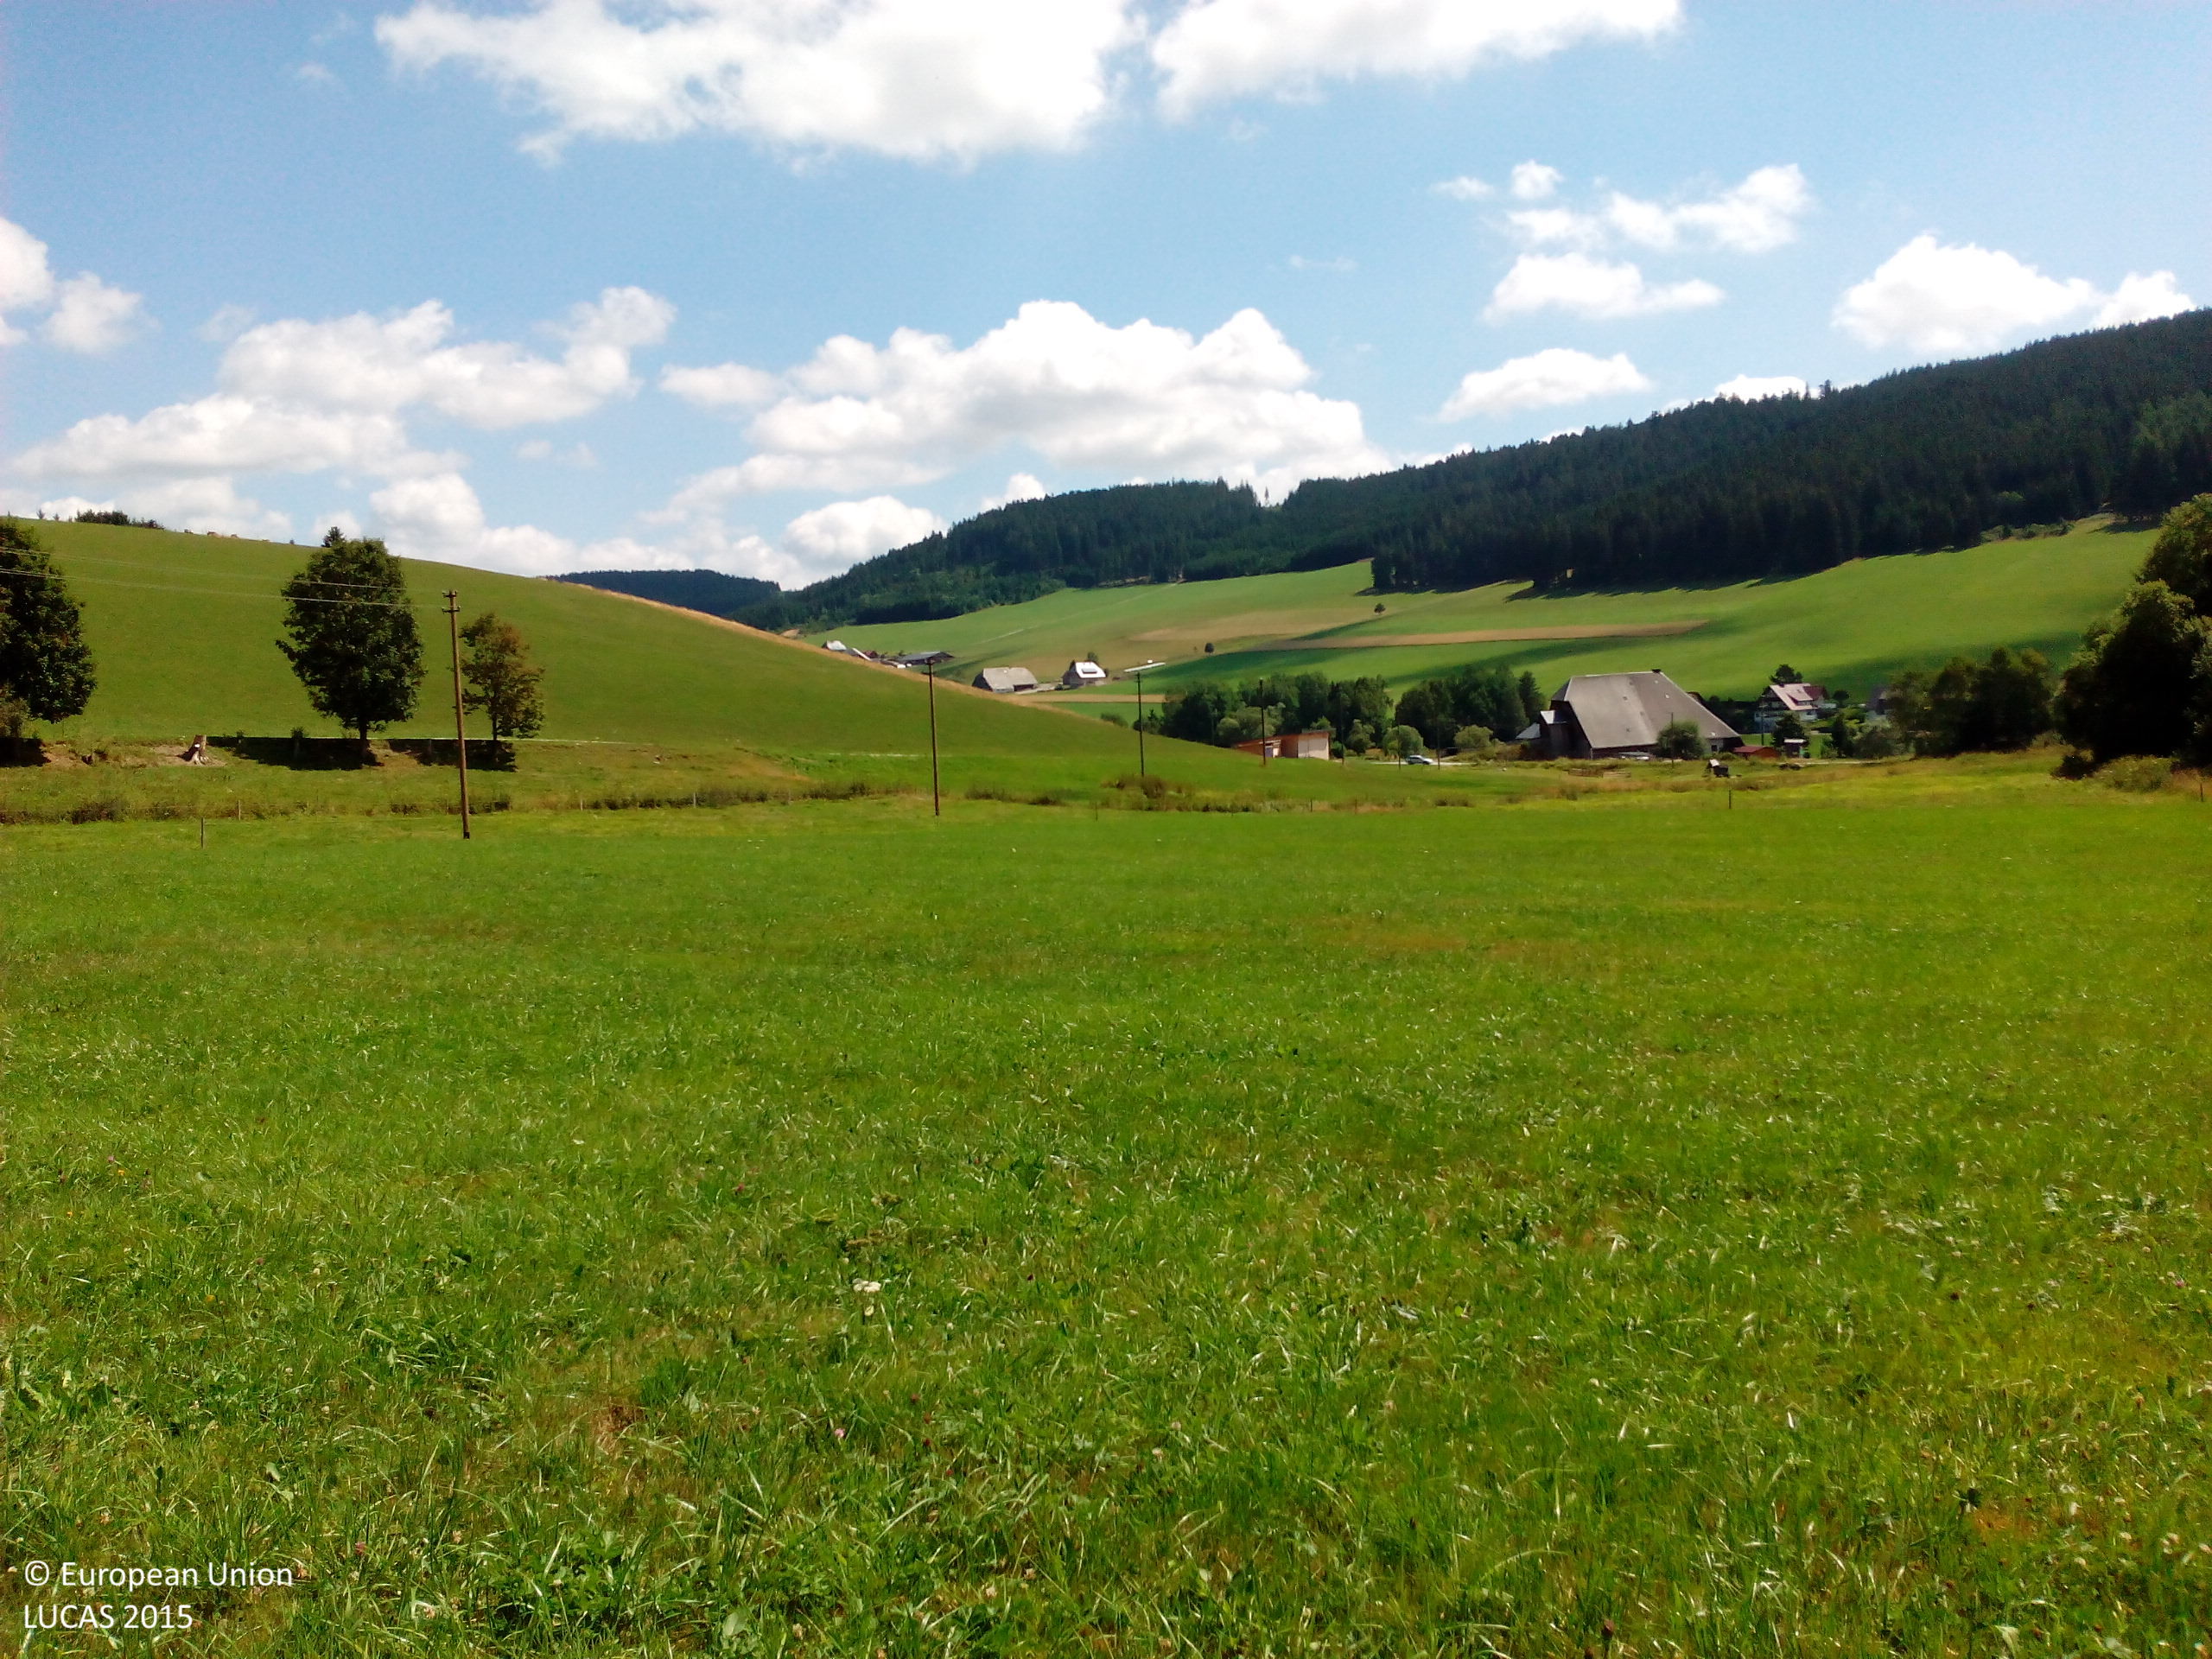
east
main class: Grassland
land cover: Grassland without tree/shrub cover
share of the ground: > 75 %
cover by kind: herbaceous plants 100 %
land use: Agriculture (excluding fallow land and kitchen gardens)
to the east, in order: Grassland without tree/shrub cover; Fences; Grassland without tree/shrub cover; Fences; Ditches and canals; Shruby margins; Grassland without tree/shrub cover; Electric lines; Grassland without tree/shrub cover; Paved roads, cycling and walking lanes; Grassland without tree/shrub cover
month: August
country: DE
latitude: 47.9387
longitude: 8.1939
